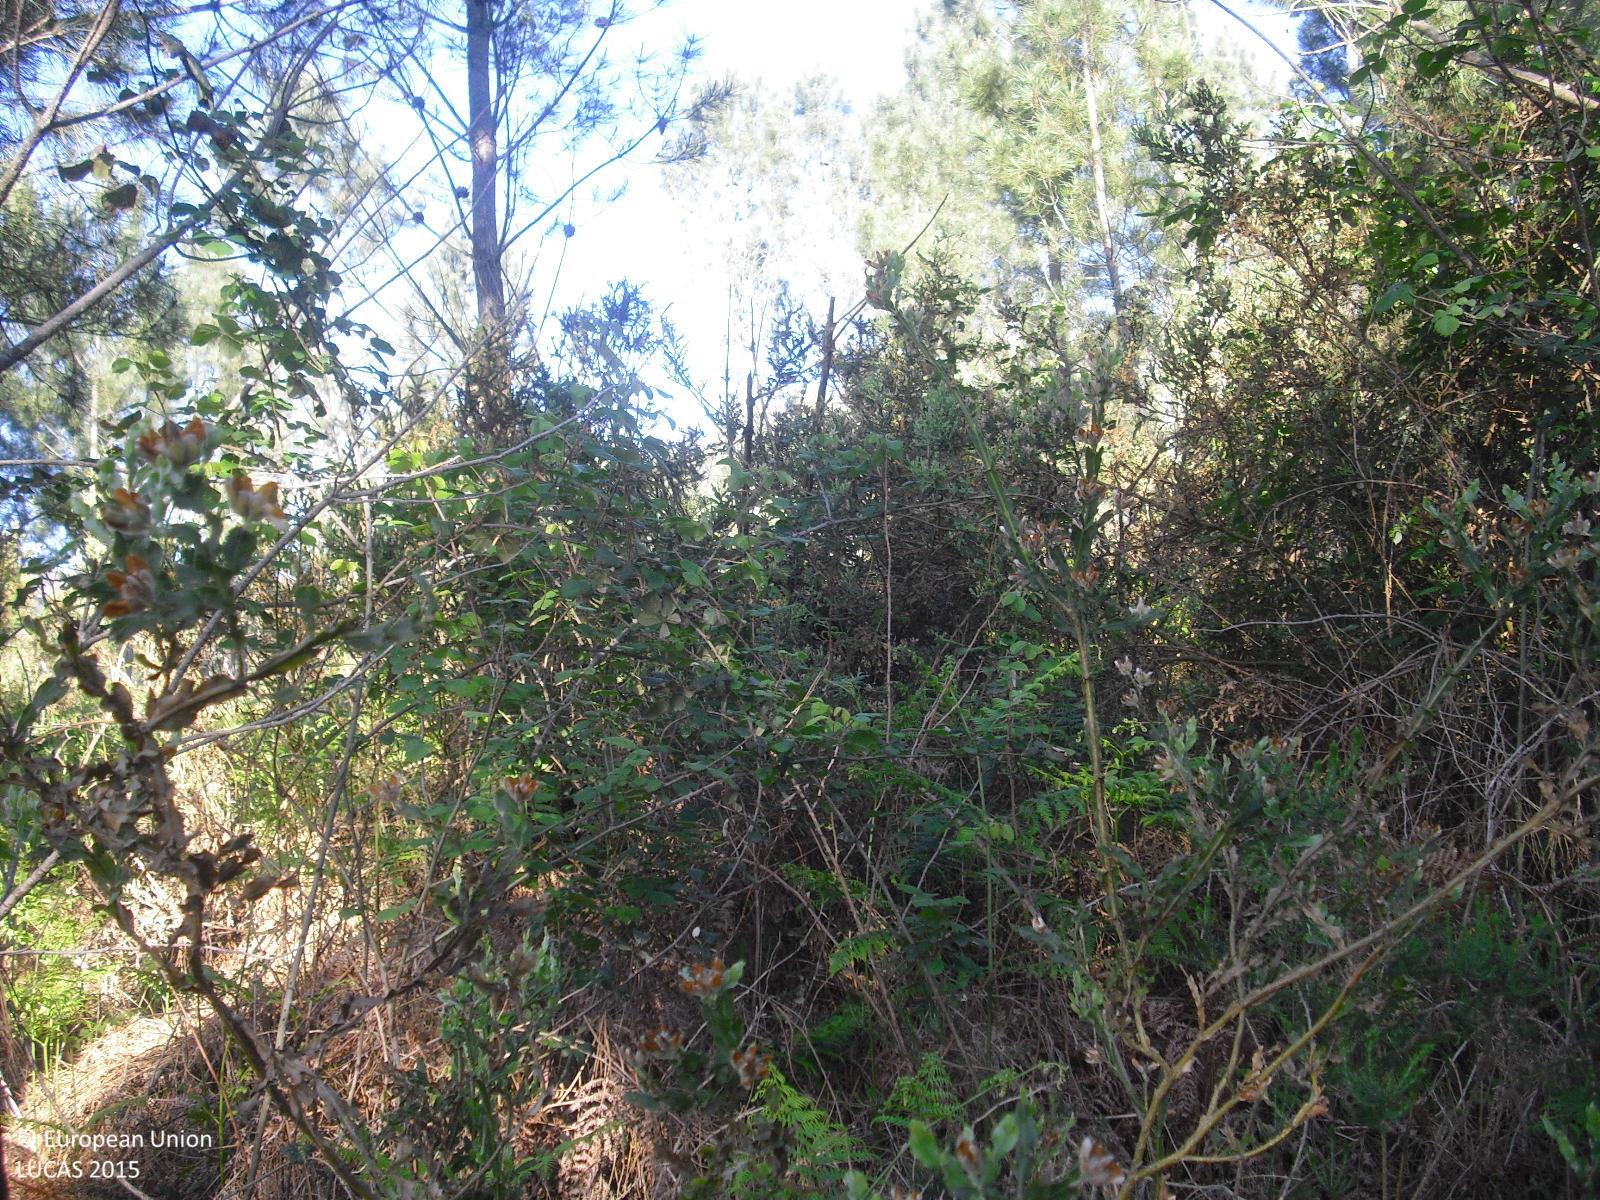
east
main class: Woodland
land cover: Pine dominated coniferous woodland
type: hemiboreal forest and nemoral coniferous forest and mixed broadleaved-coniferous forest
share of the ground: 25 - 50 %
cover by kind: coniferous forest trees 50 %, shrubs 50 %
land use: Forestry
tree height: > 5 m
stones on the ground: 25 - 50 %
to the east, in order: Pine dominated coniferous woodland; Shrubland with sparse tree cover; Pine dominated coniferous woodland; Shrubland without tree cover; Tracks; Pine dominated coniferous woodland; Pine dominated mixed woodland; Pine dominated coniferous woodland; Rock outcrops; Pine dominated coniferous woodland; Rocks and stones; Shrubland with sparse tree cover; Rock outcrops; Pine dominated coniferous woodland; Rock outcrops; Pine dominated coniferous woodland; Rocks and stones; Shrubland with sparse tree cover; Rocks and stones
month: May
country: ES
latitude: 41.8942
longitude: -8.1958
